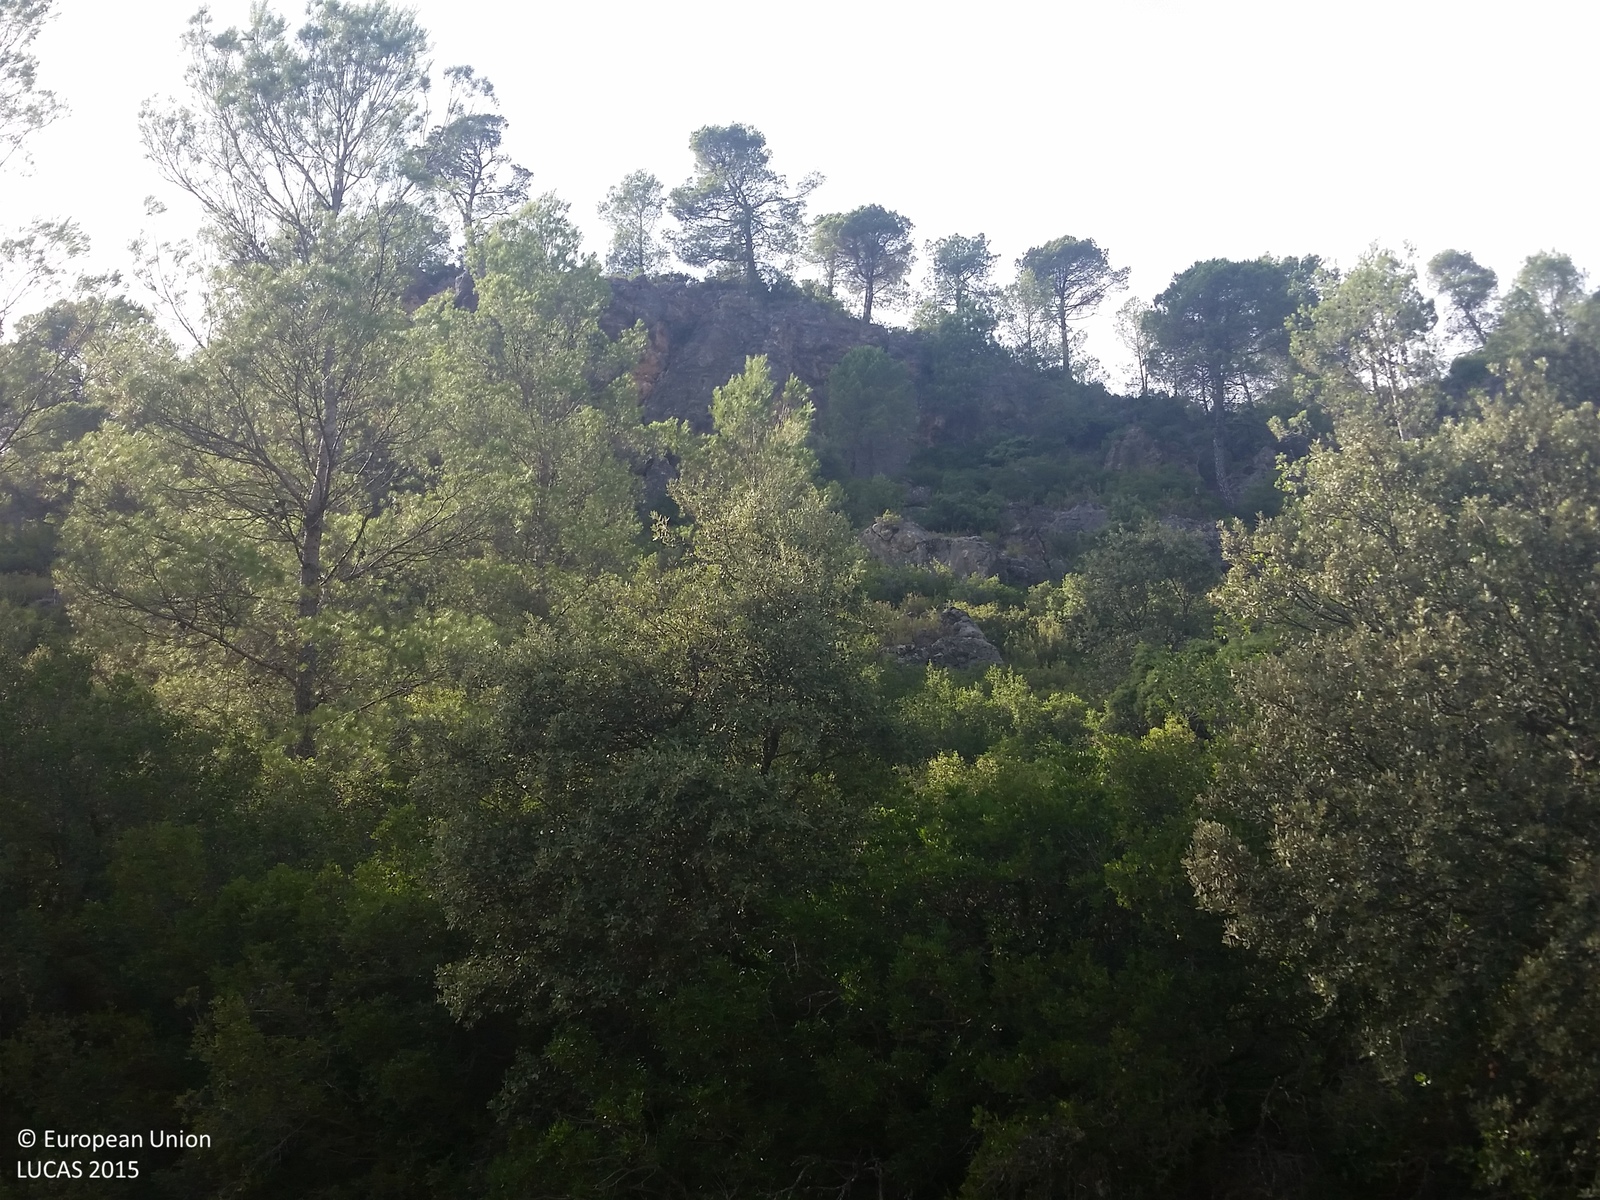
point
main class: Woodland
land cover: Pine dominated coniferous woodland
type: coniferous forest of the mediterranean region
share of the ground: > 75 %
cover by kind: coniferous forest trees 90 %, shrubs 10 %
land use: Semi-natural and natural areas not in use
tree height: > 5 m
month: August
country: ES
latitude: 38.4640
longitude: -2.5946
